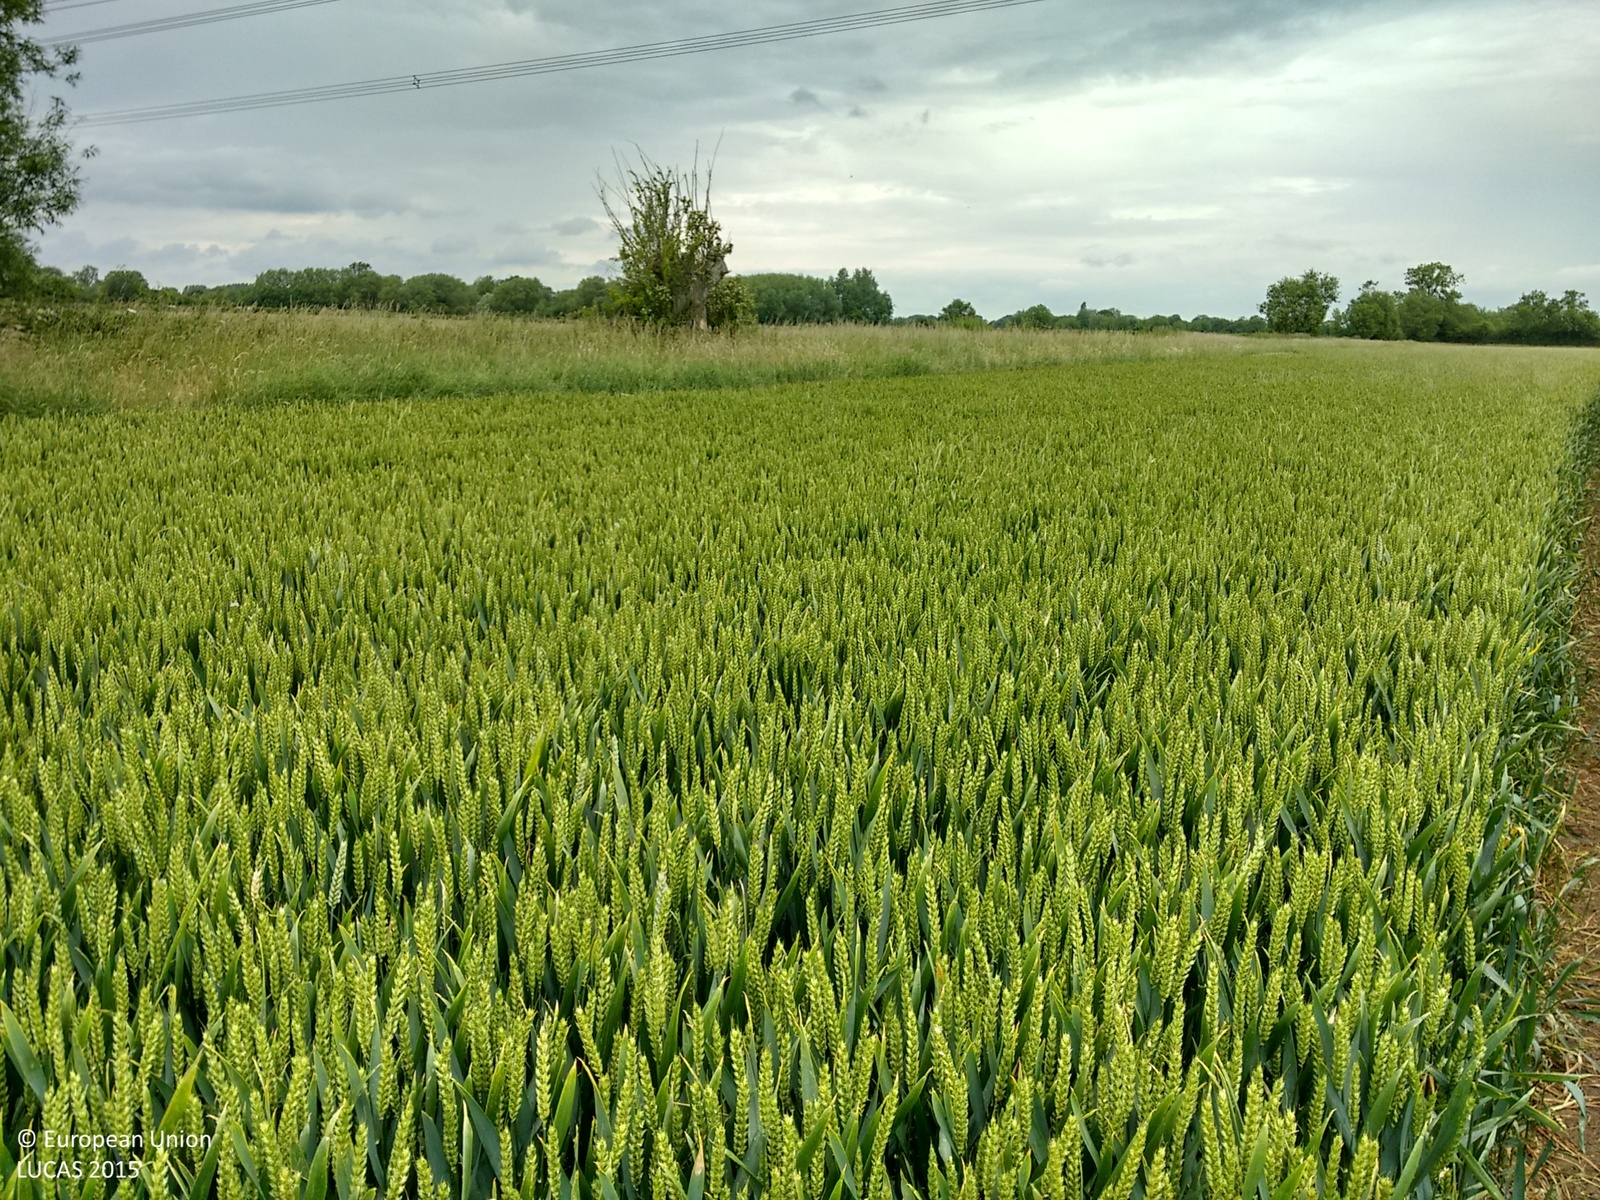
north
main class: Cropland
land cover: Common wheat
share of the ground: > 75 %
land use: Agriculture (excluding fallow land and kitchen gardens)
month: June
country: GB
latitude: 51.6963
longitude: -1.6126
